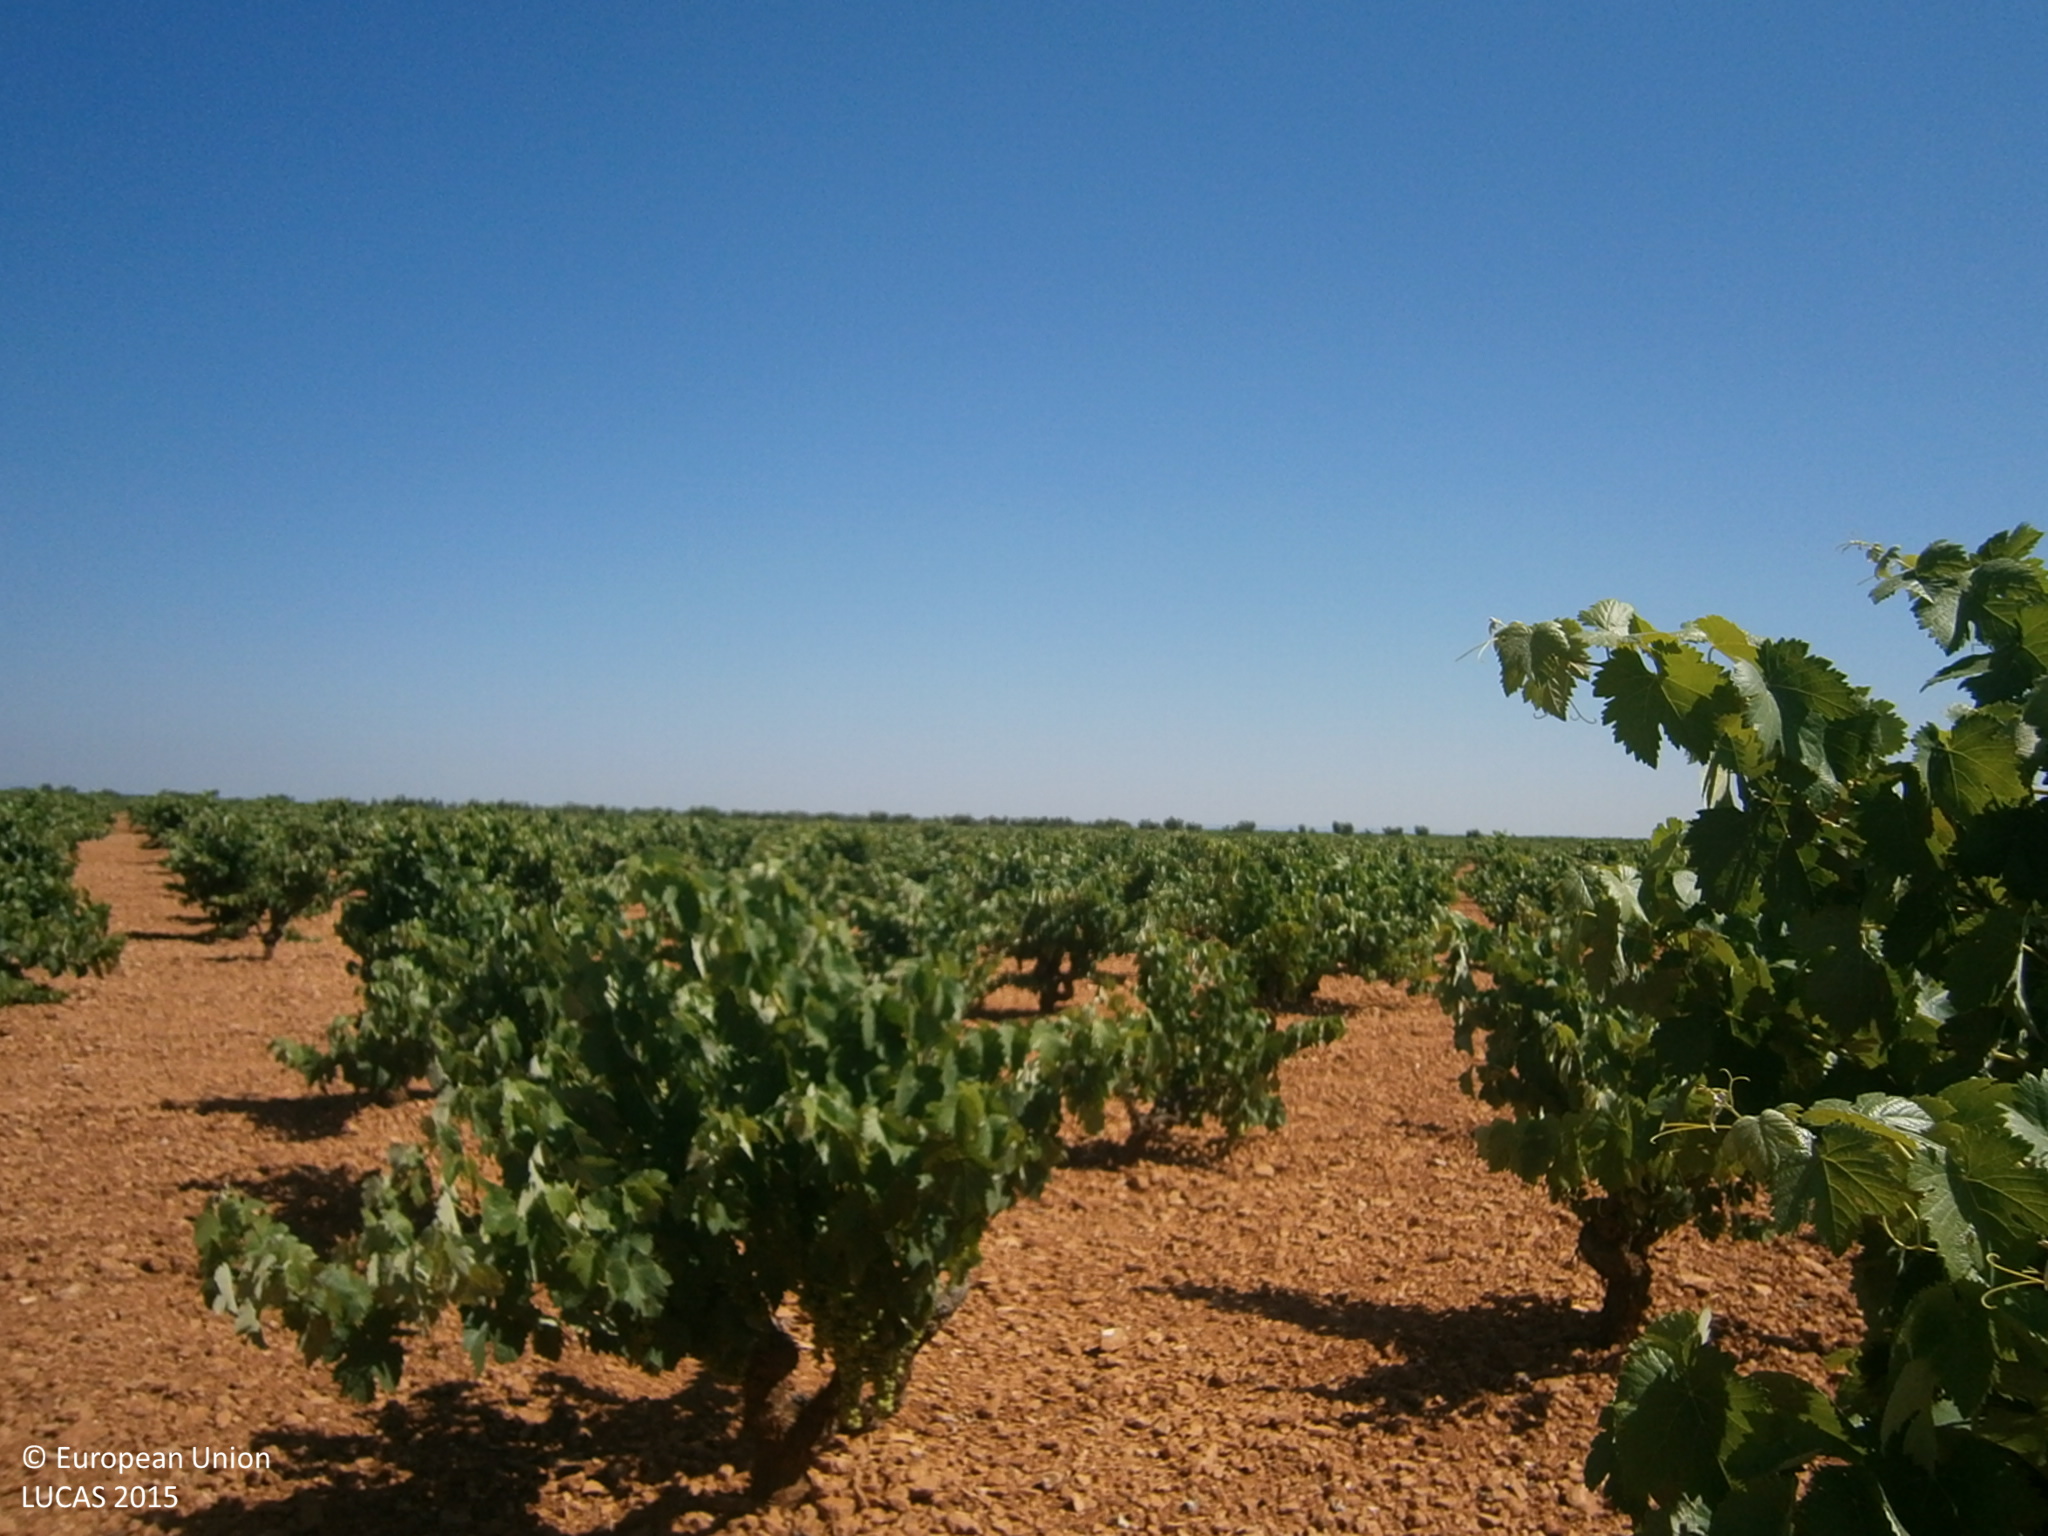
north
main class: Cropland
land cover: Vineyards
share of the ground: 25 - 50 %
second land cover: Other bare soil
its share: > 75 %
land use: Agriculture (excluding fallow land and kitchen gardens)
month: June
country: ES
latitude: 38.7567
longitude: -6.6664
